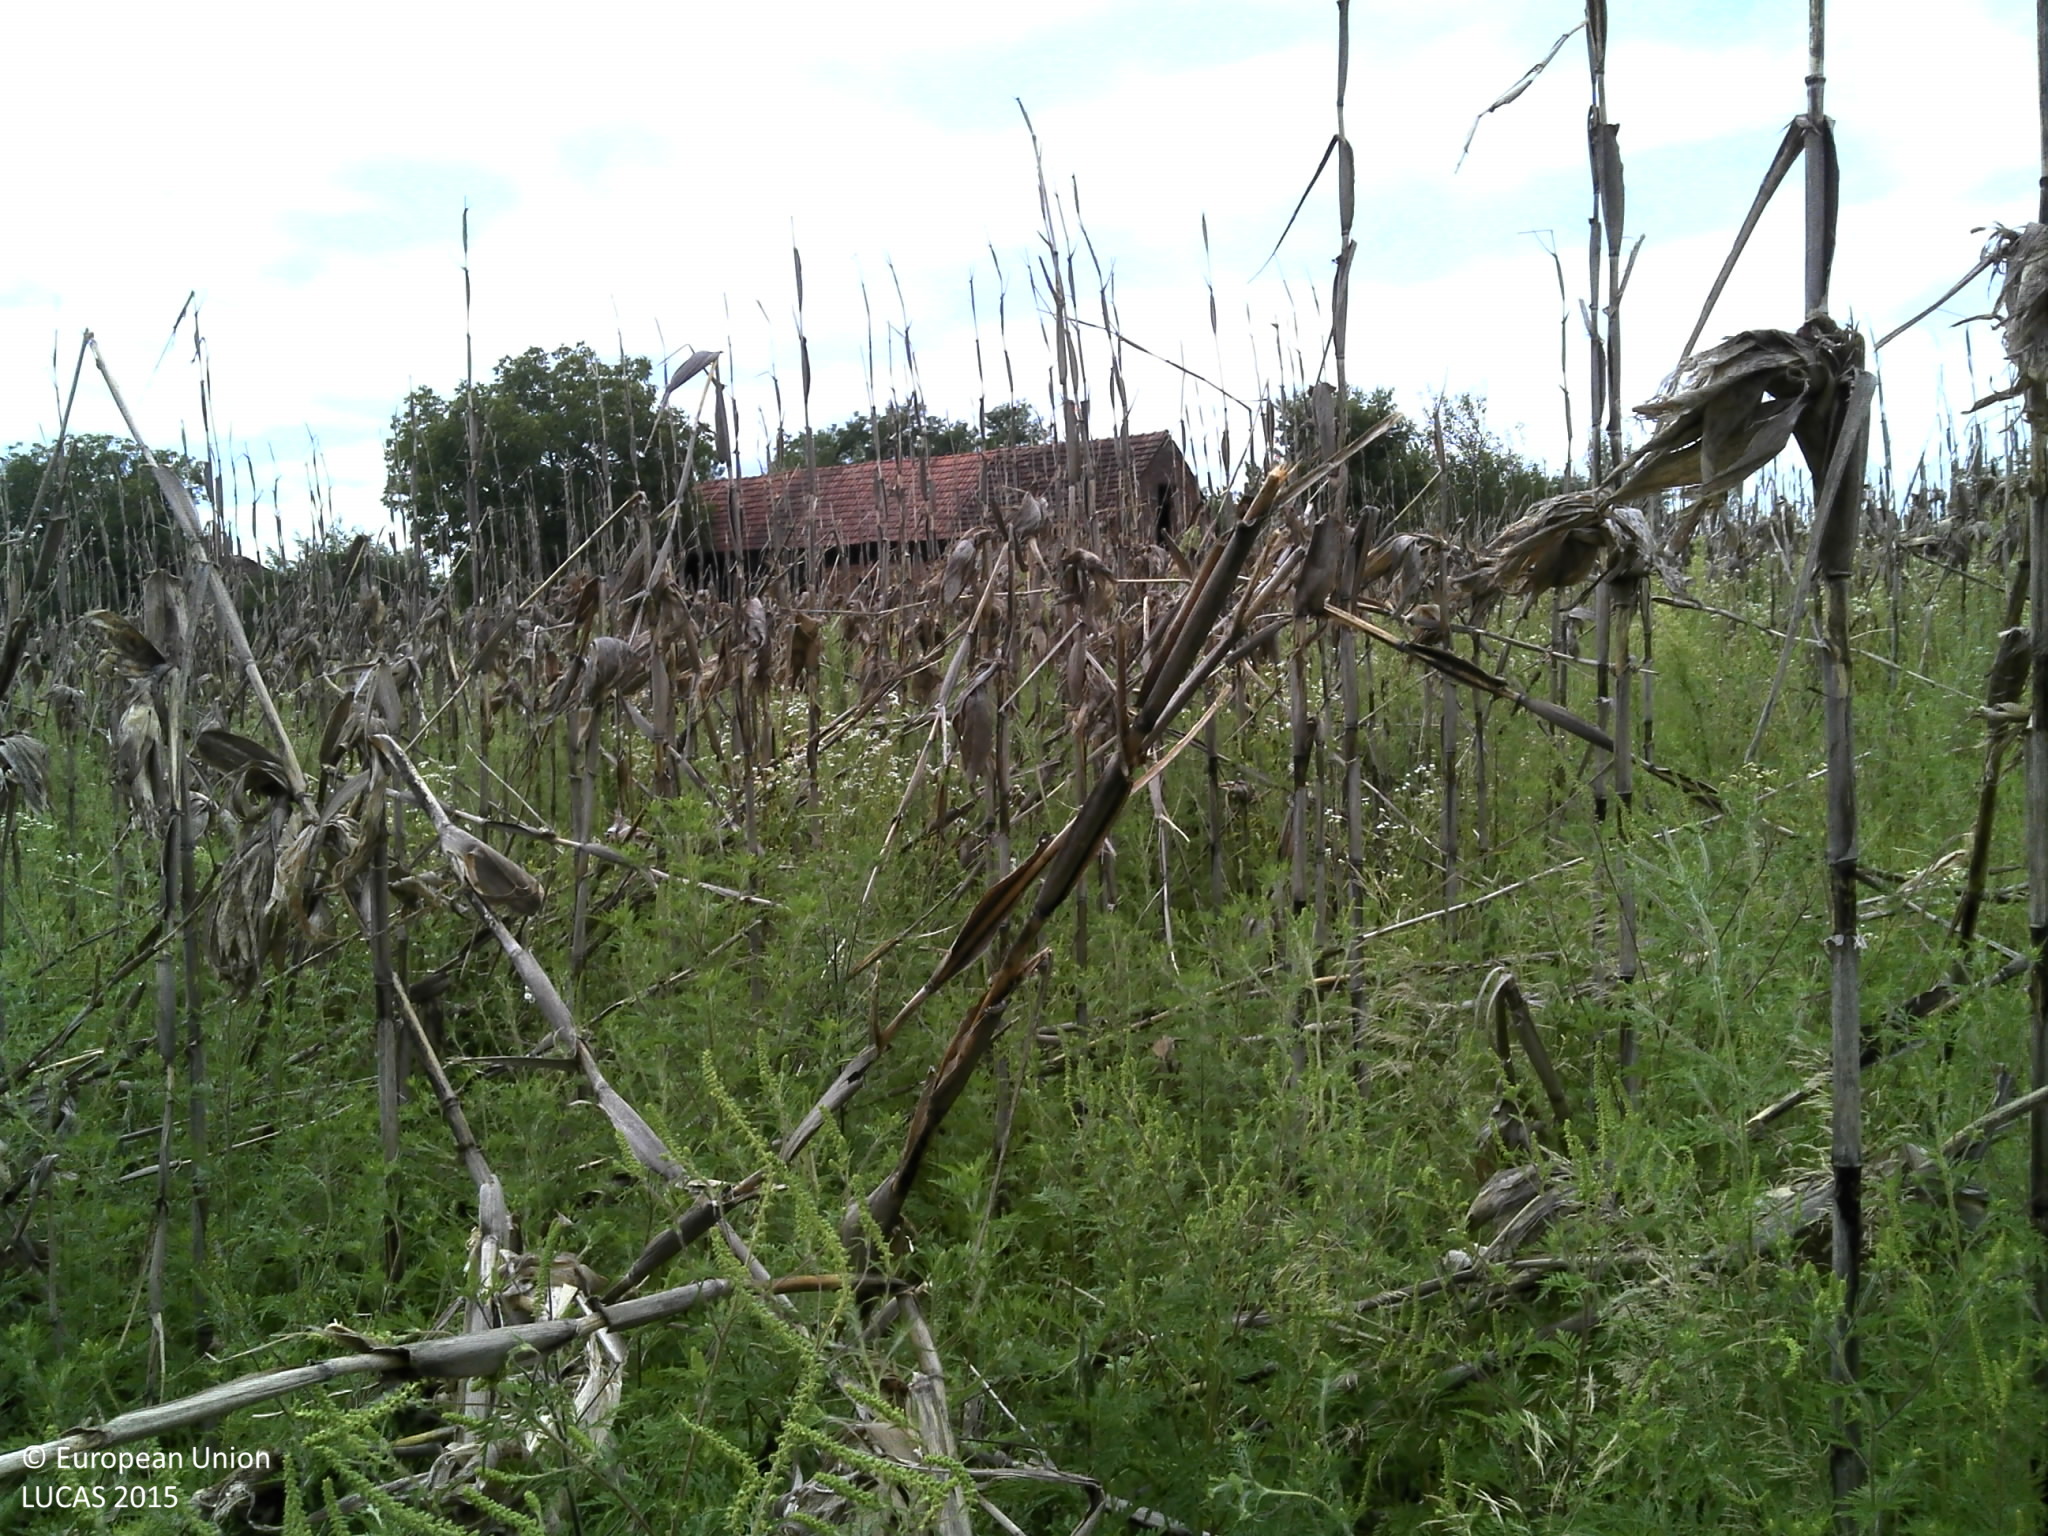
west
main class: Grassland
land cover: Spontaneously vegetated surfaces
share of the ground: > 75 %
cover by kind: herbaceous plants 100 %
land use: Semi-natural and natural areas not in use
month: July
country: HR
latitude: 45.6034
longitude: 16.6274
